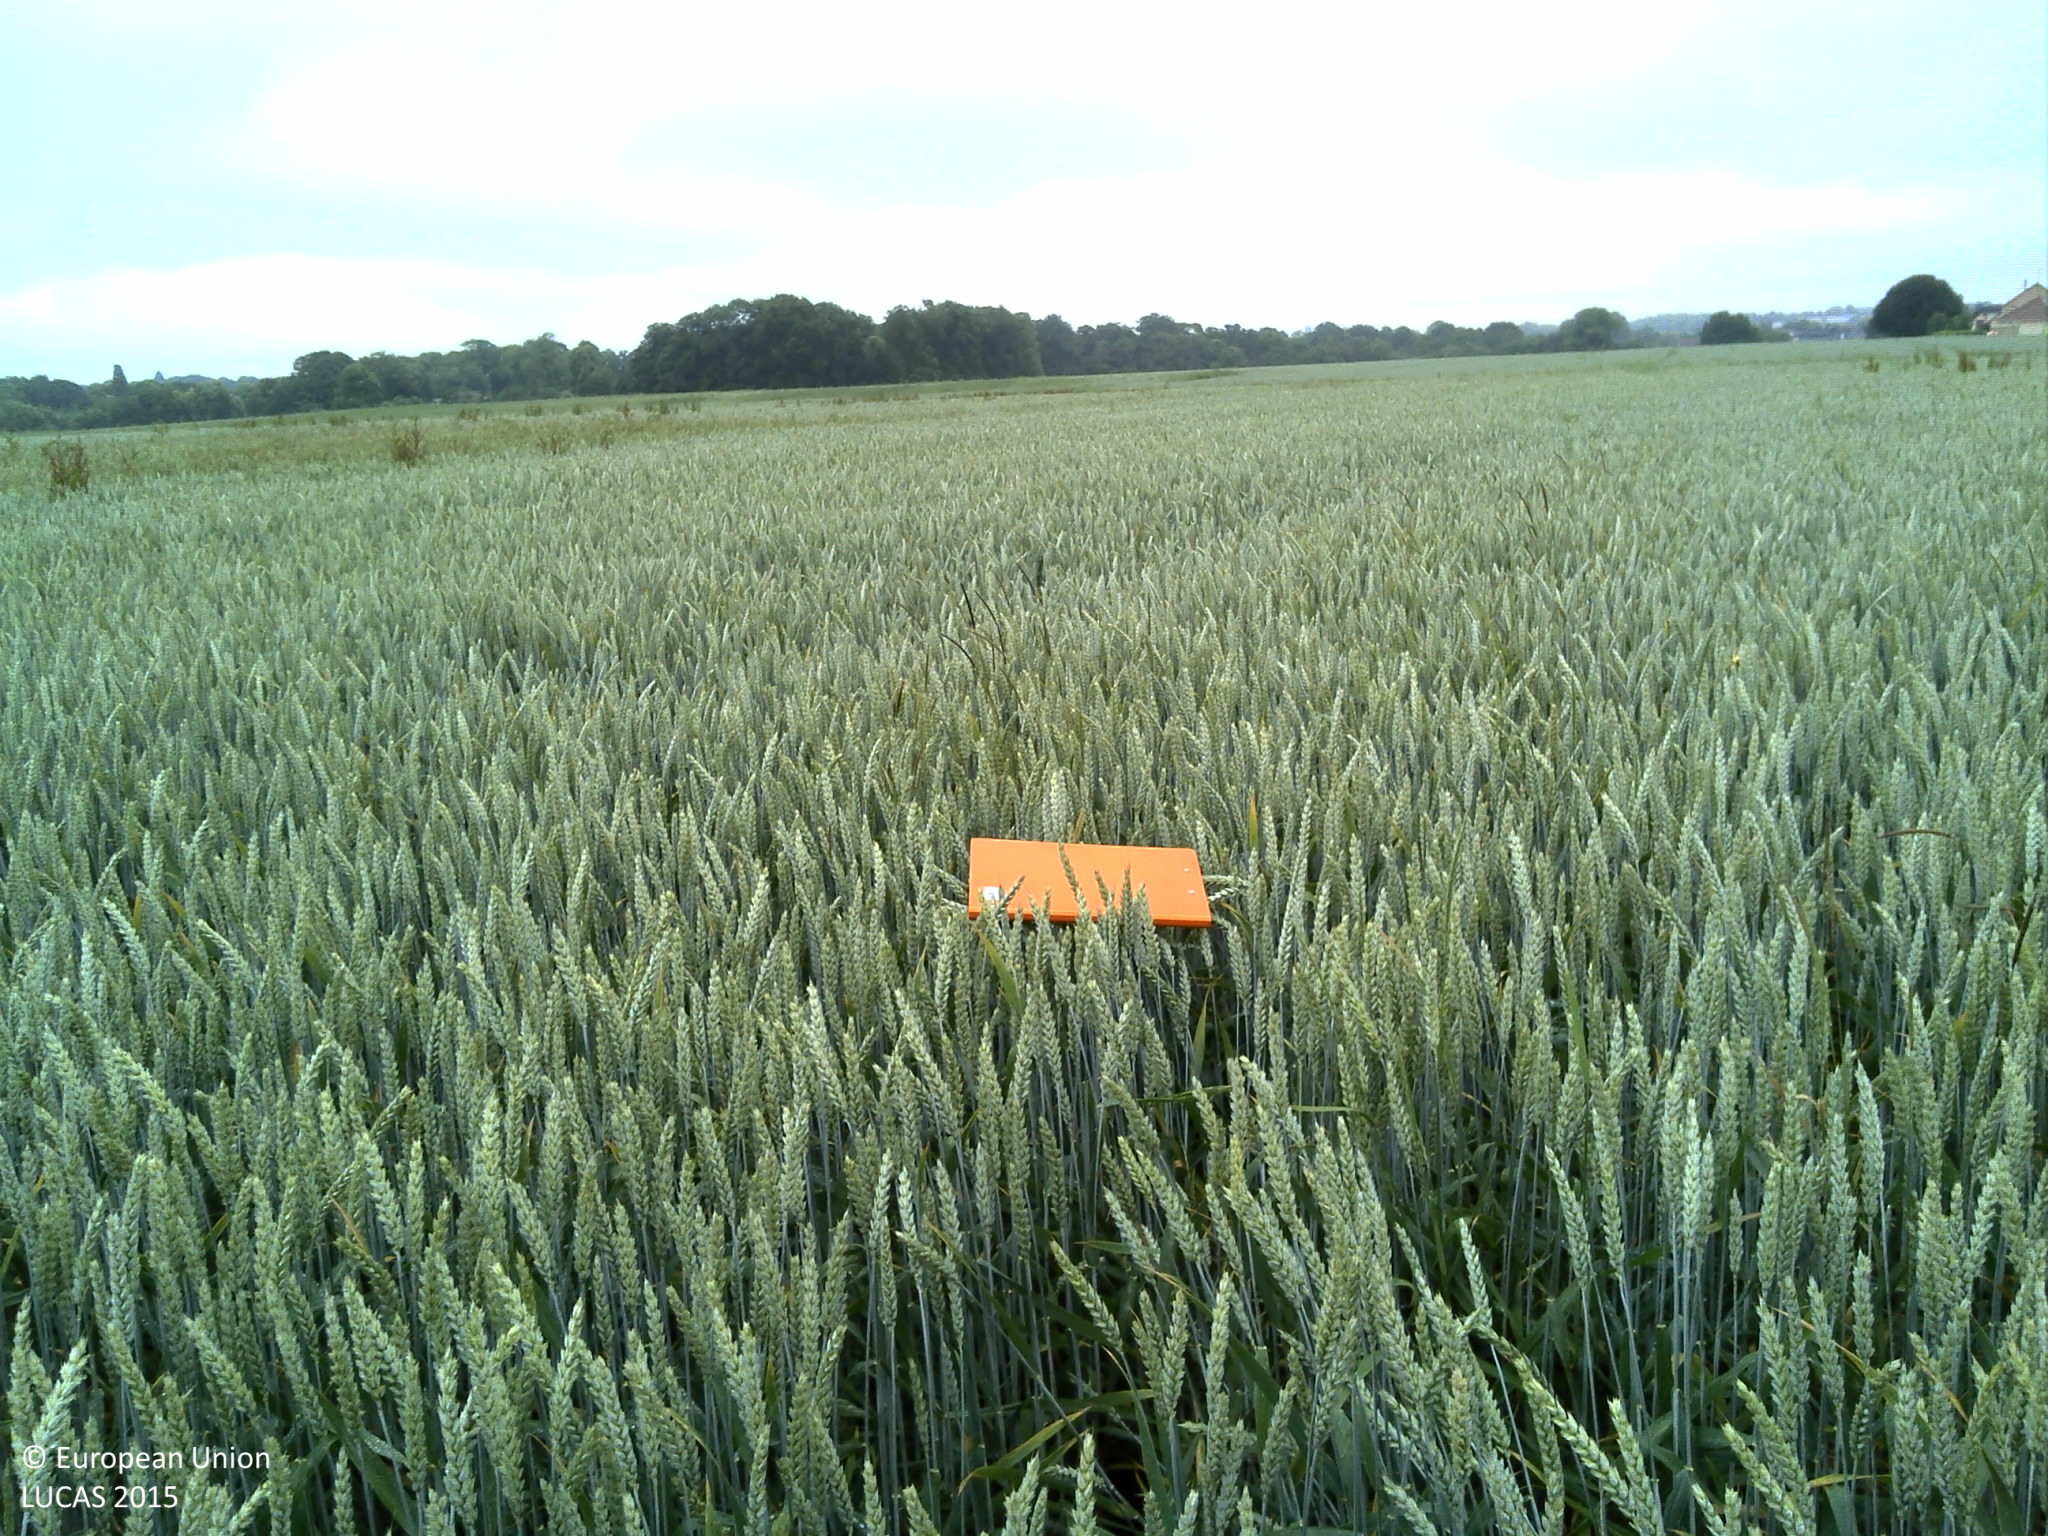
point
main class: Cropland
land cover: Common wheat
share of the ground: > 75 %
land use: Agriculture (excluding fallow land and kitchen gardens)
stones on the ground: 10 - 25 %
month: June
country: FR
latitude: 49.4228
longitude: 1.1419
